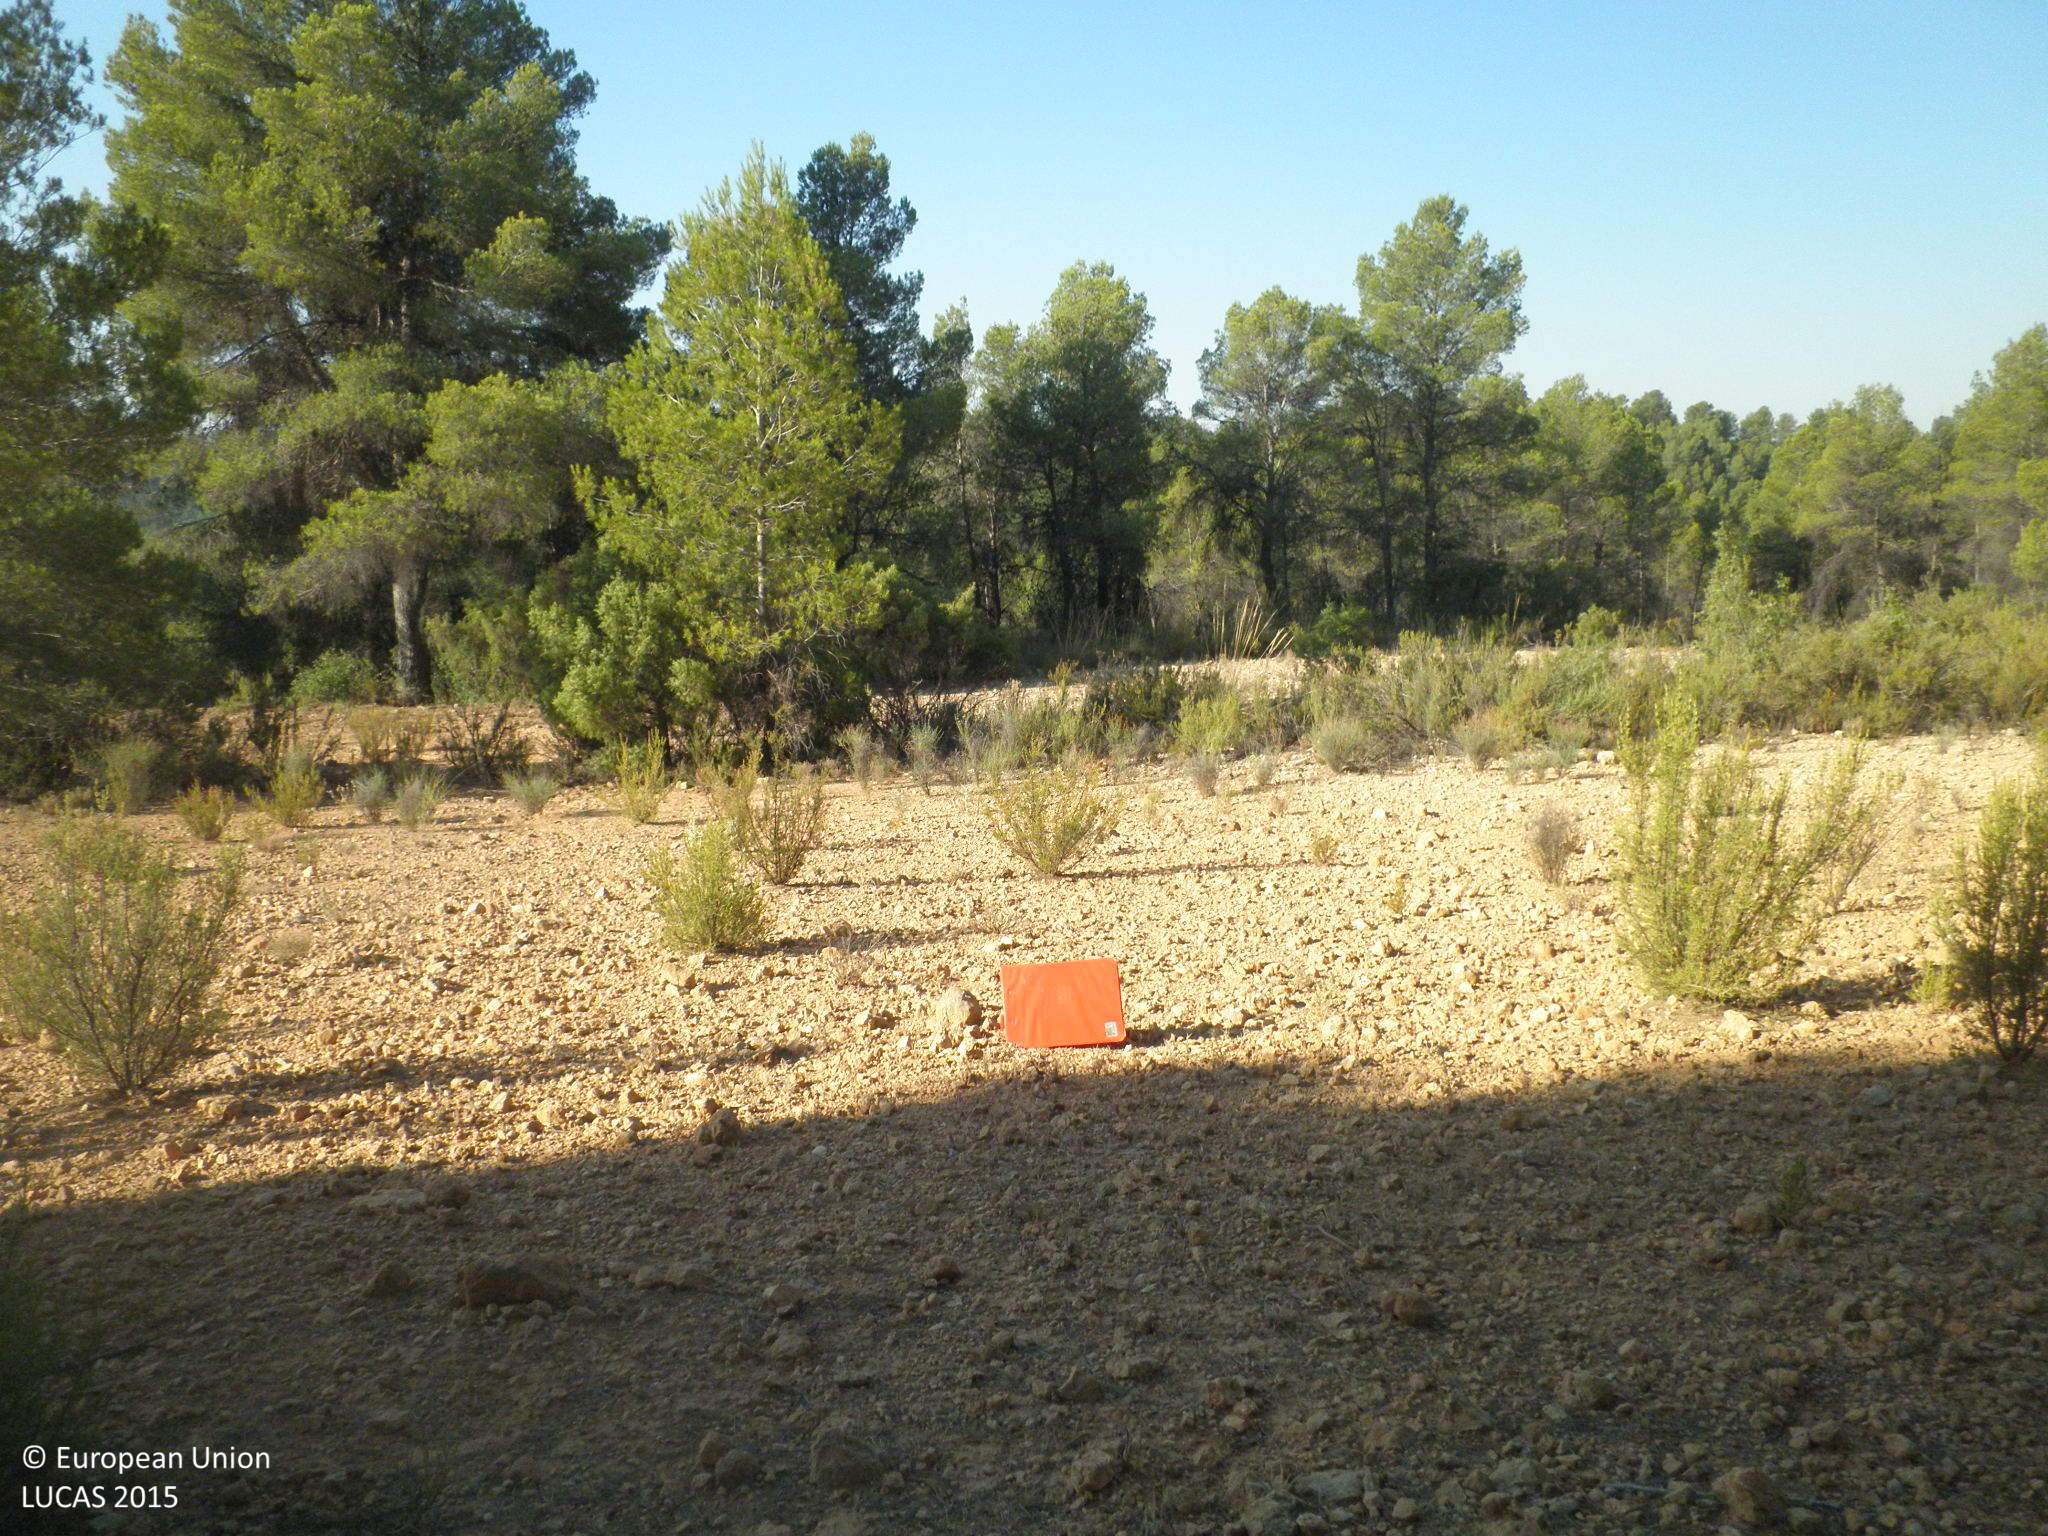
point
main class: Shrubland
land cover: Shrubland without tree cover
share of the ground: 10 - 25 %
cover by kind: unconsolidated bare surface 90 %, shrubs 10 %
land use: Semi-natural and natural areas not in use
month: July
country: ES
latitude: 39.4020
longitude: -1.5345
